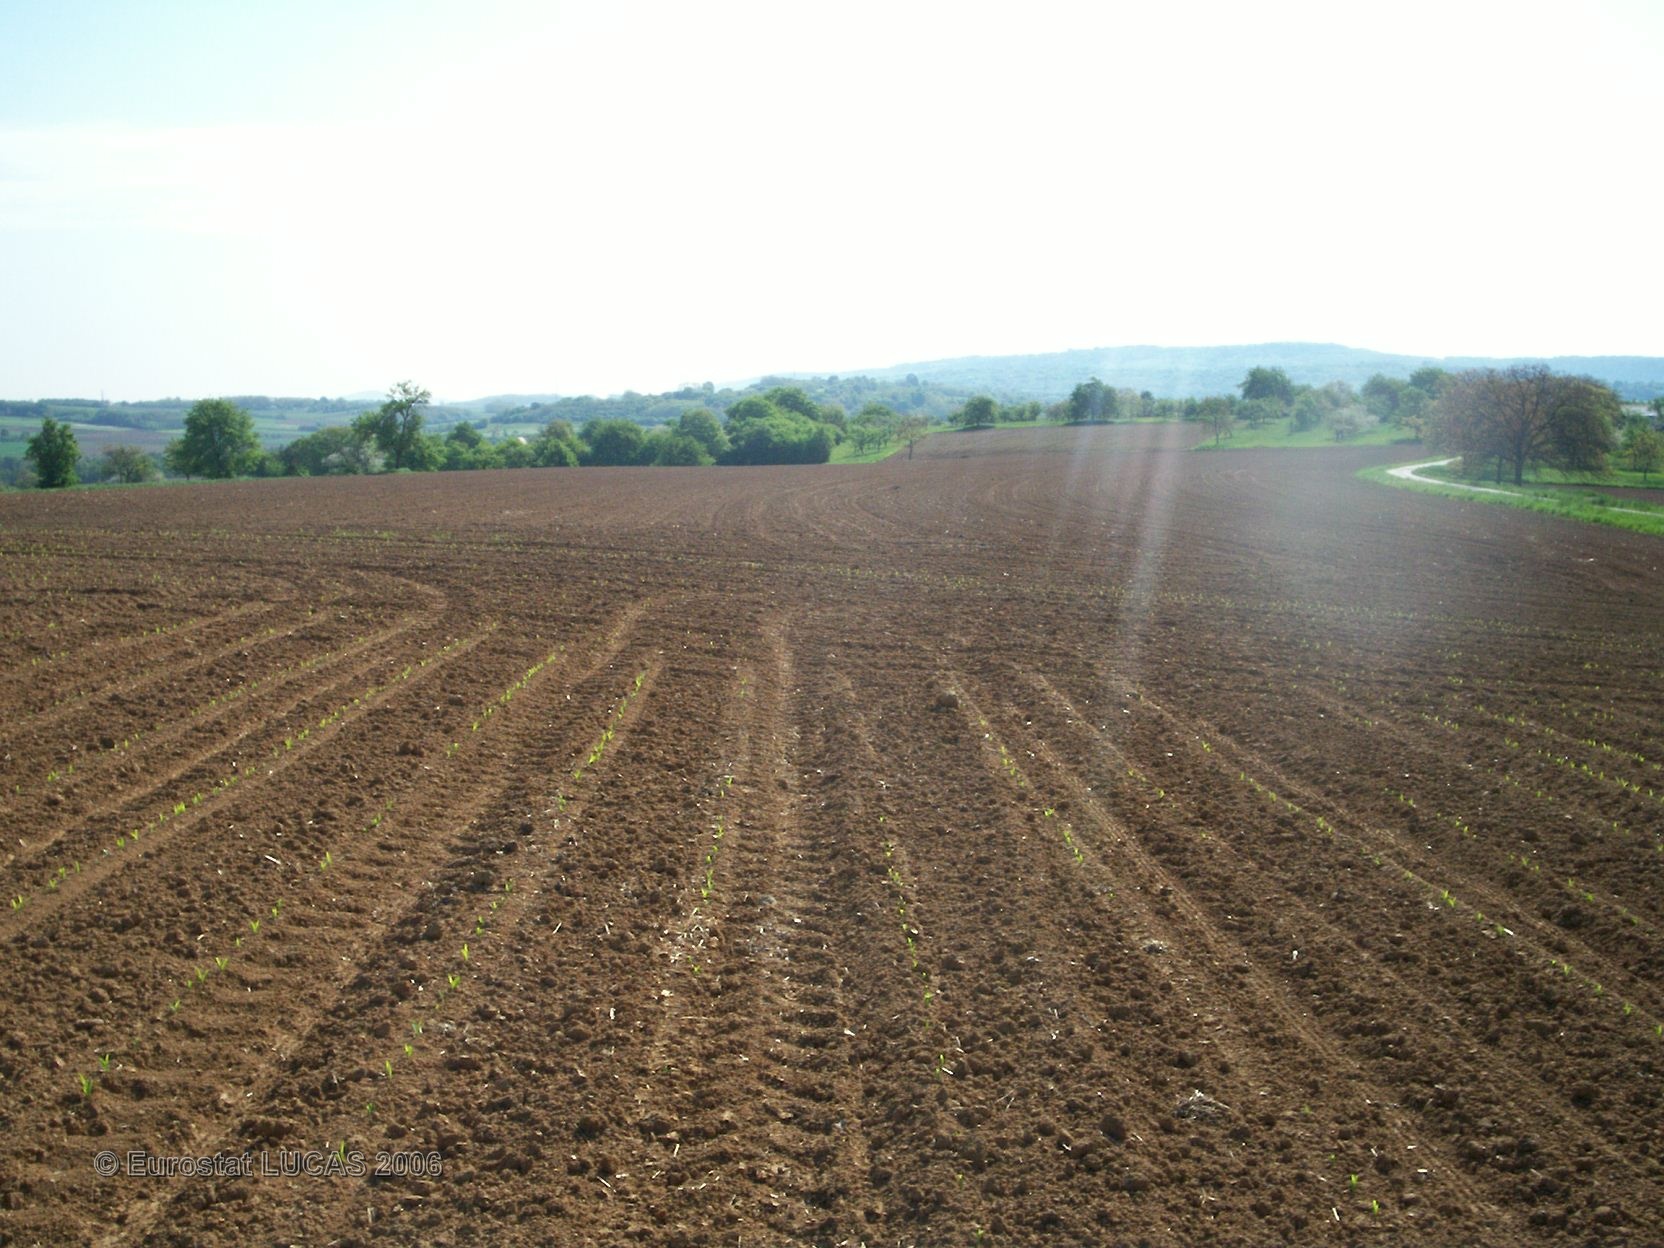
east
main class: Cropland
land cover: Maize
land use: Agriculture (excluding fallow land and kitchen gardens)
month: May
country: FR
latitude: 48.5526
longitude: 7.3861
